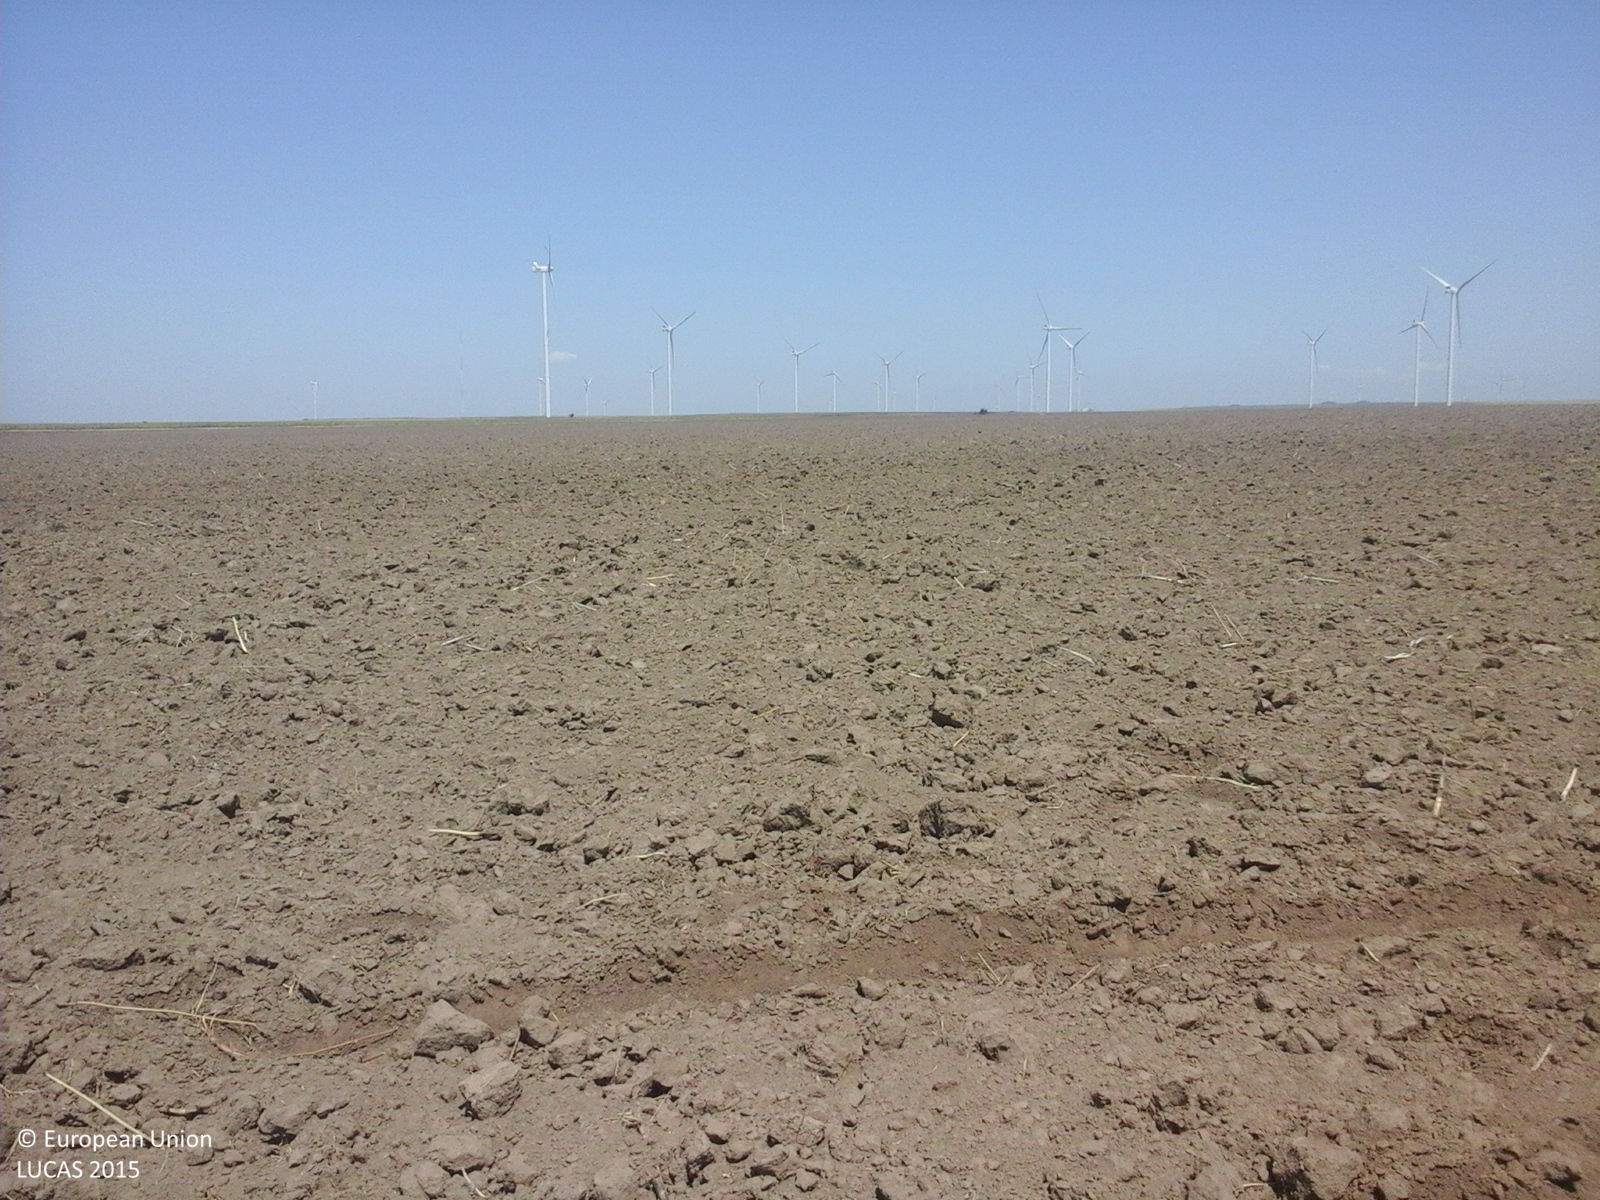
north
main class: Cropland
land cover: Rape and turnip rape
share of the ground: < 10 %
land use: Agriculture (excluding fallow land and kitchen gardens)
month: August
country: RO
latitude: 44.5462
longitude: 28.2278
